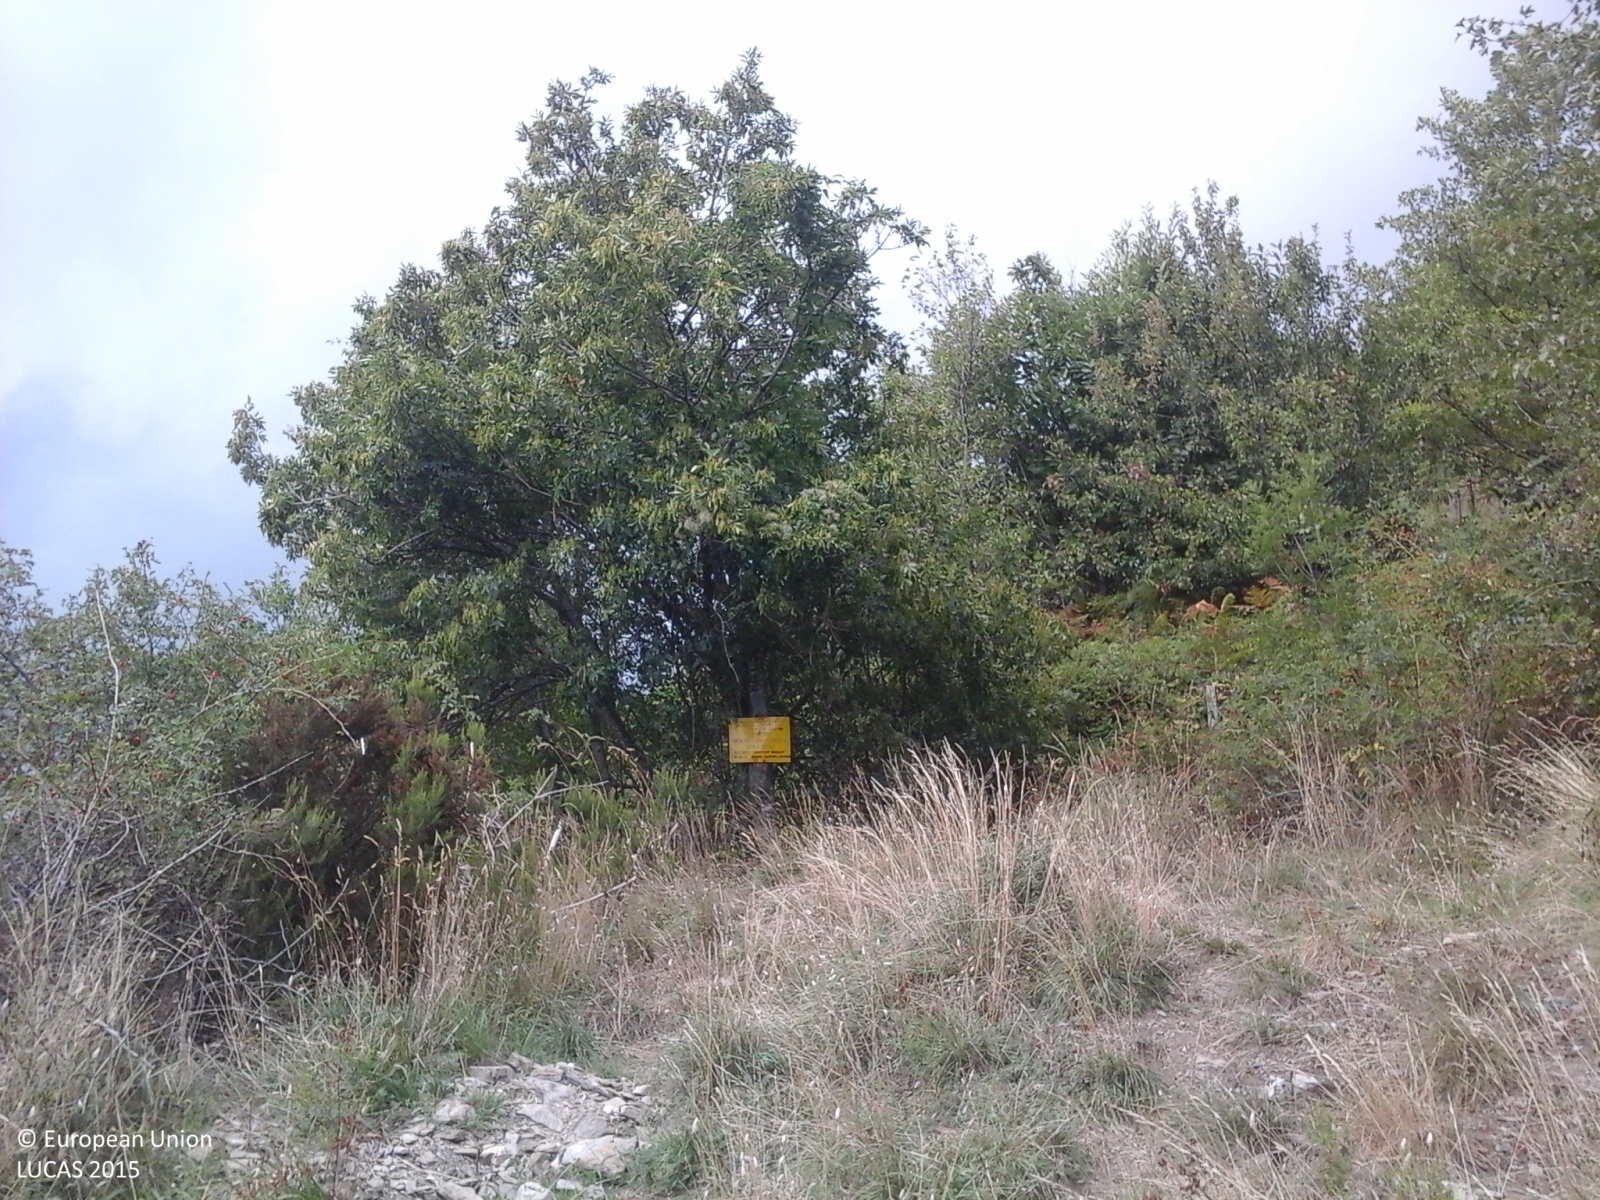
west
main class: Woodland
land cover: Broadleaved woodland
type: thermophilous deciduous forest
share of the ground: > 75 %
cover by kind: broadleaved forest trees 100 %
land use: Forestry
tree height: > 5 m
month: September
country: IT
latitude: 44.4558
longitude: 9.2100
